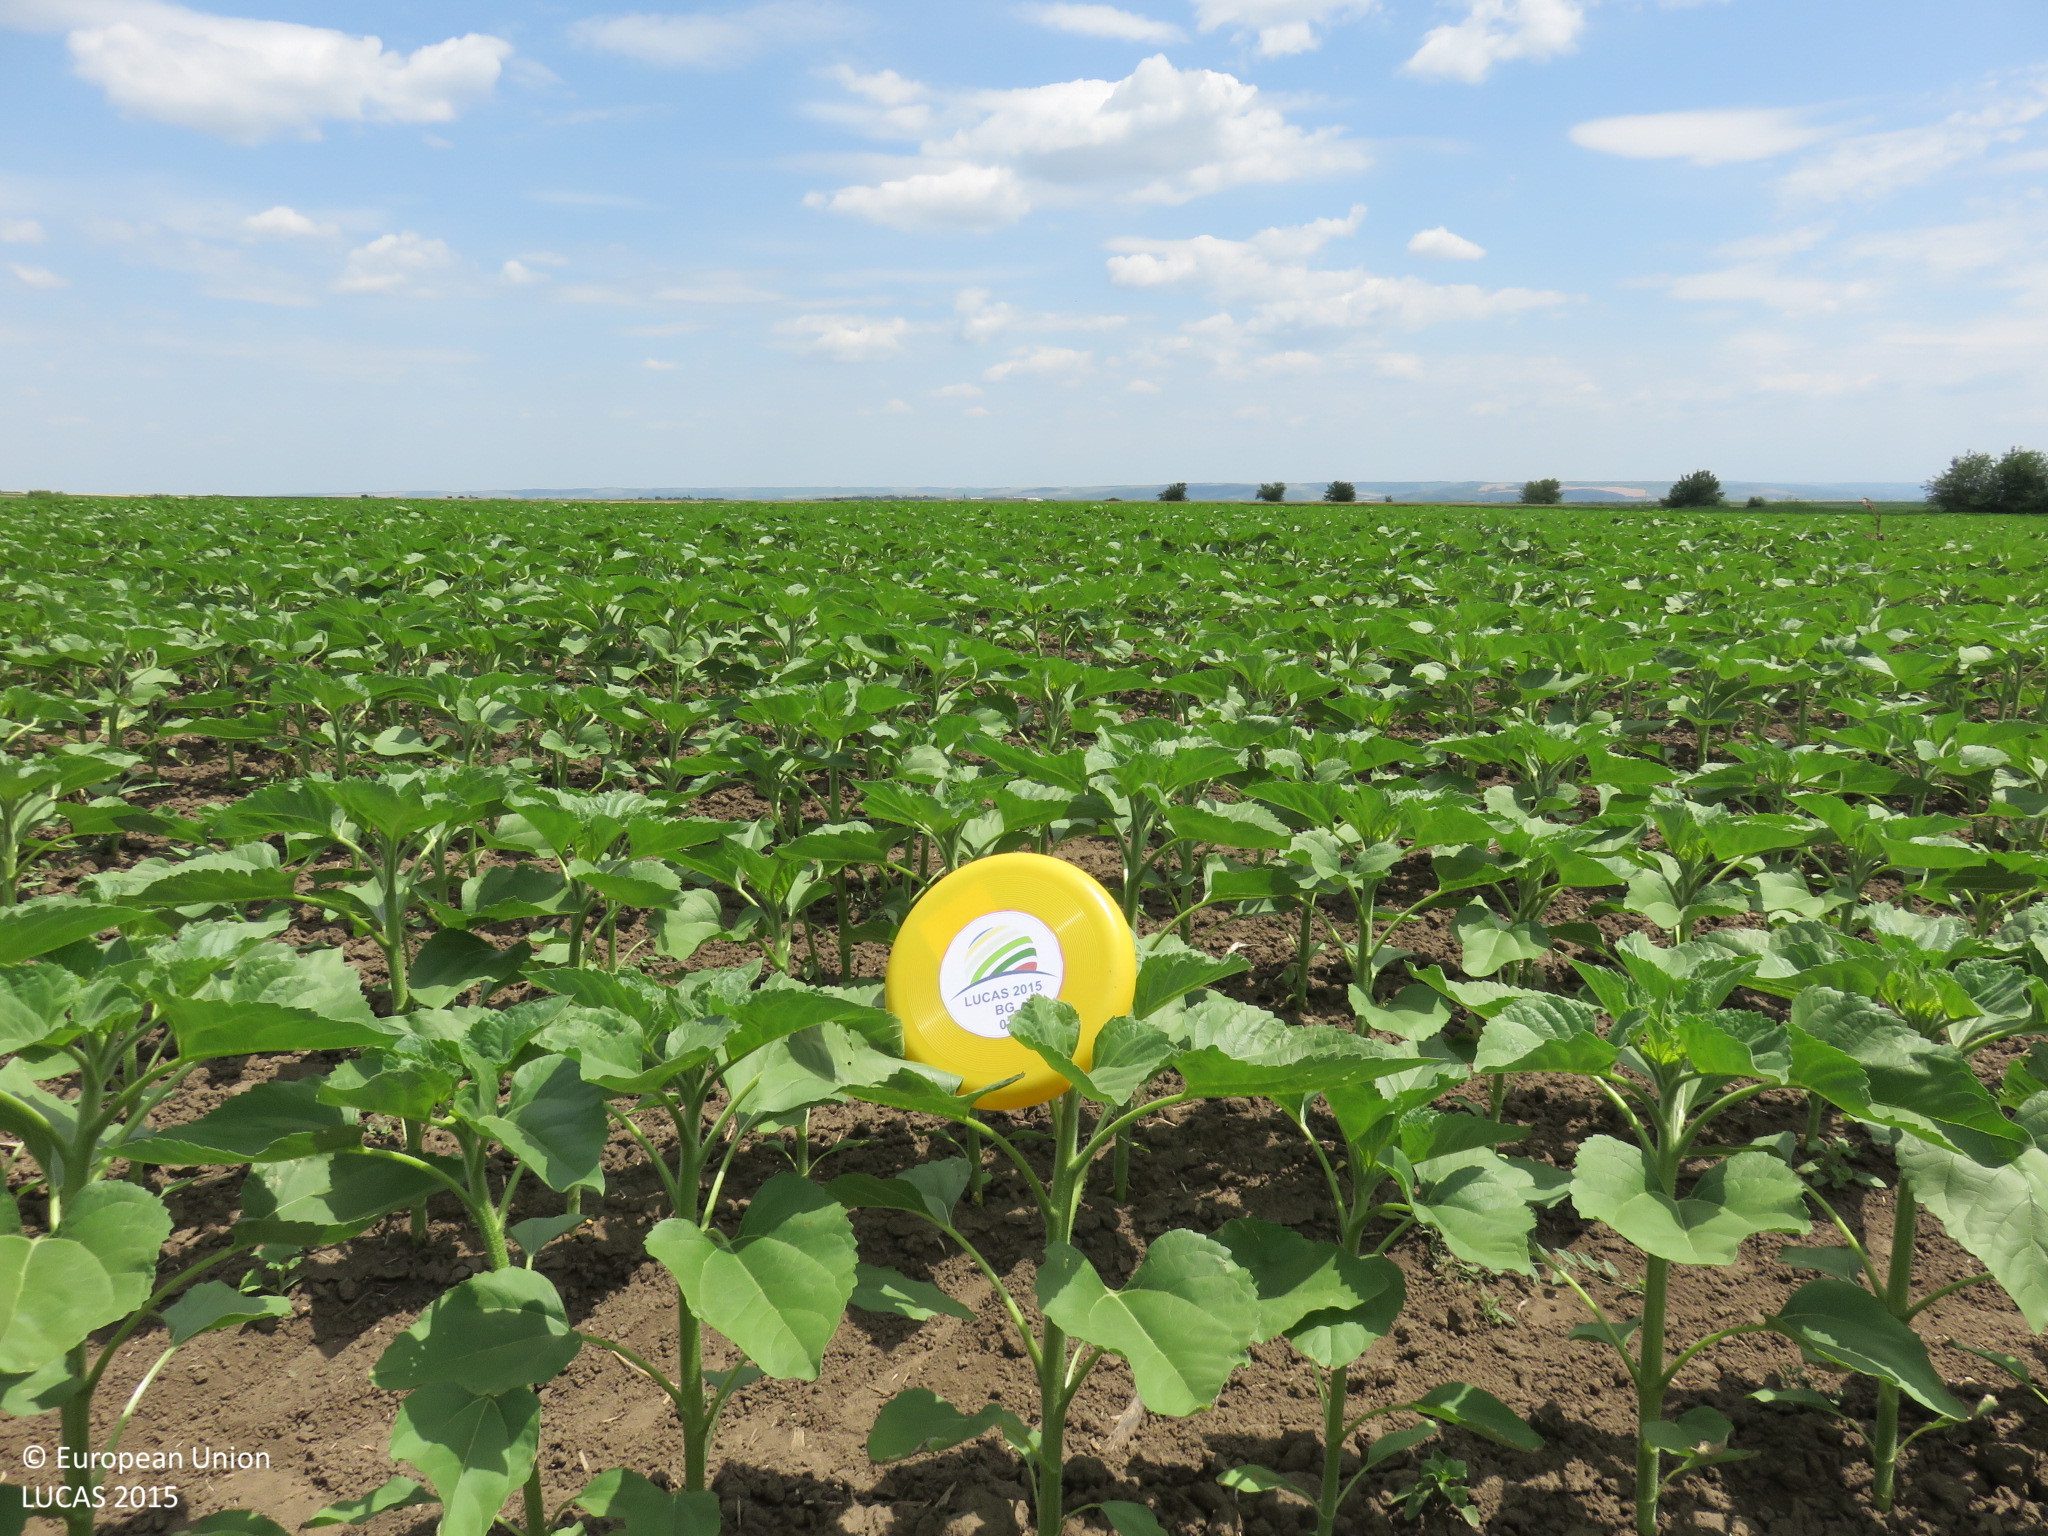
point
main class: Cropland
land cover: Sunflower
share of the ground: > 75 %
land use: Agriculture (excluding fallow land and kitchen gardens)
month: June
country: BG
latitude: 43.5020
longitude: 24.4193
